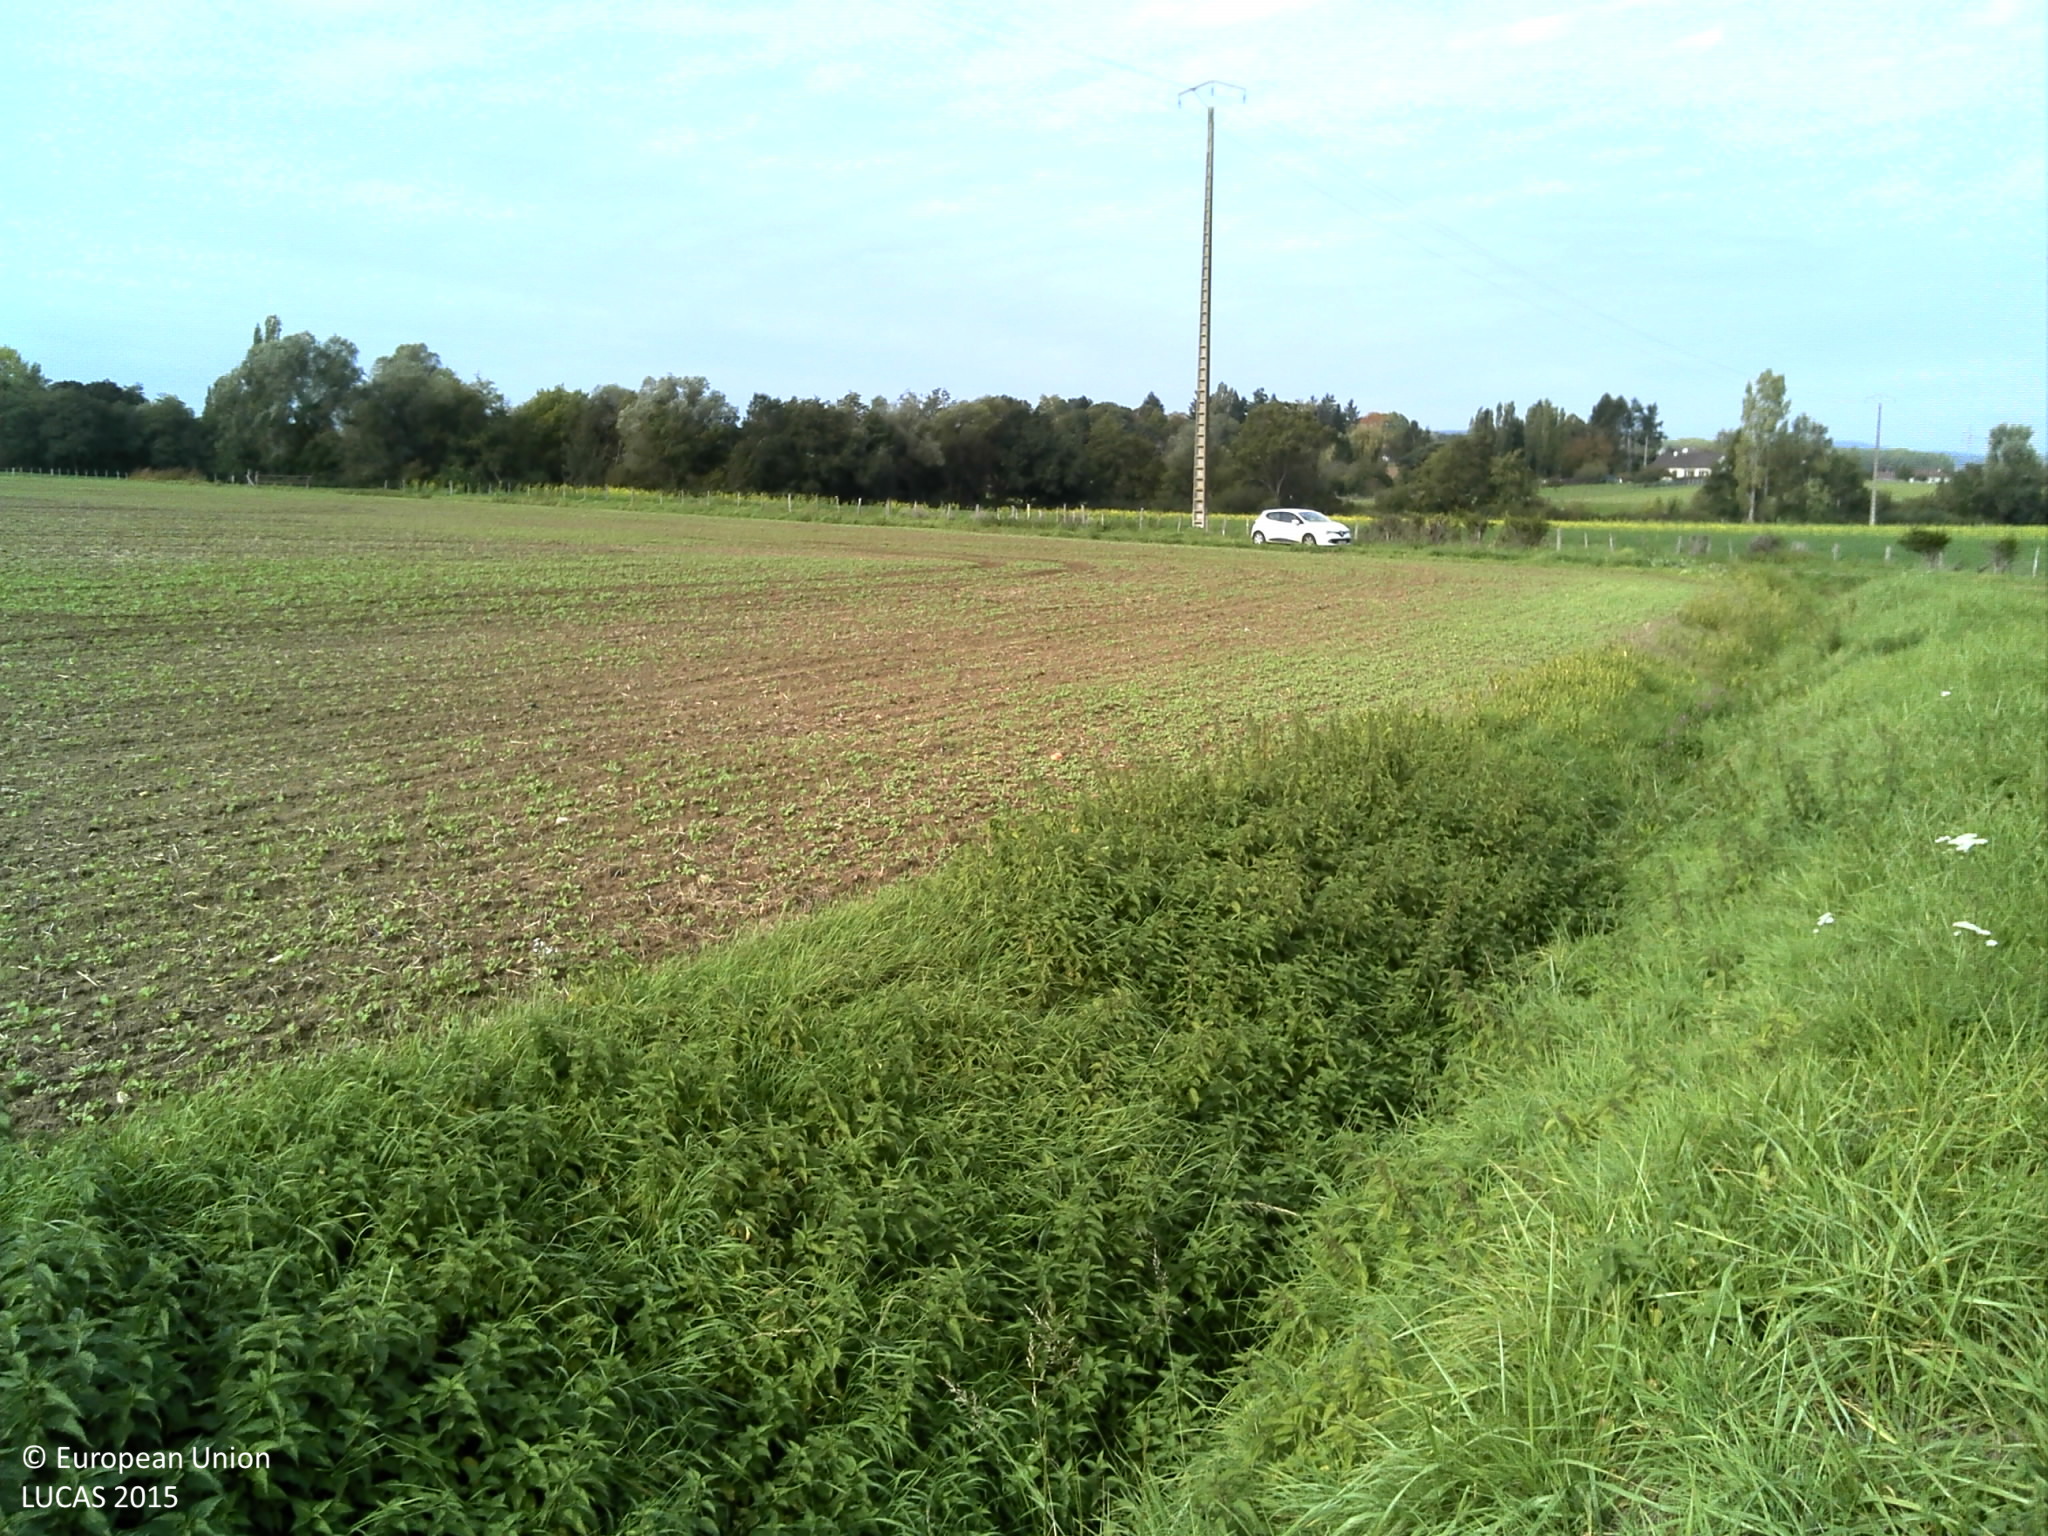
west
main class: Grassland
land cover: Grassland without tree/shrub cover
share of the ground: > 75 %
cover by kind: herbaceous plants 100 %
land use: Semi-natural and natural areas not in use
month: June
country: FR
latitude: 46.7496
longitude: 4.8307
